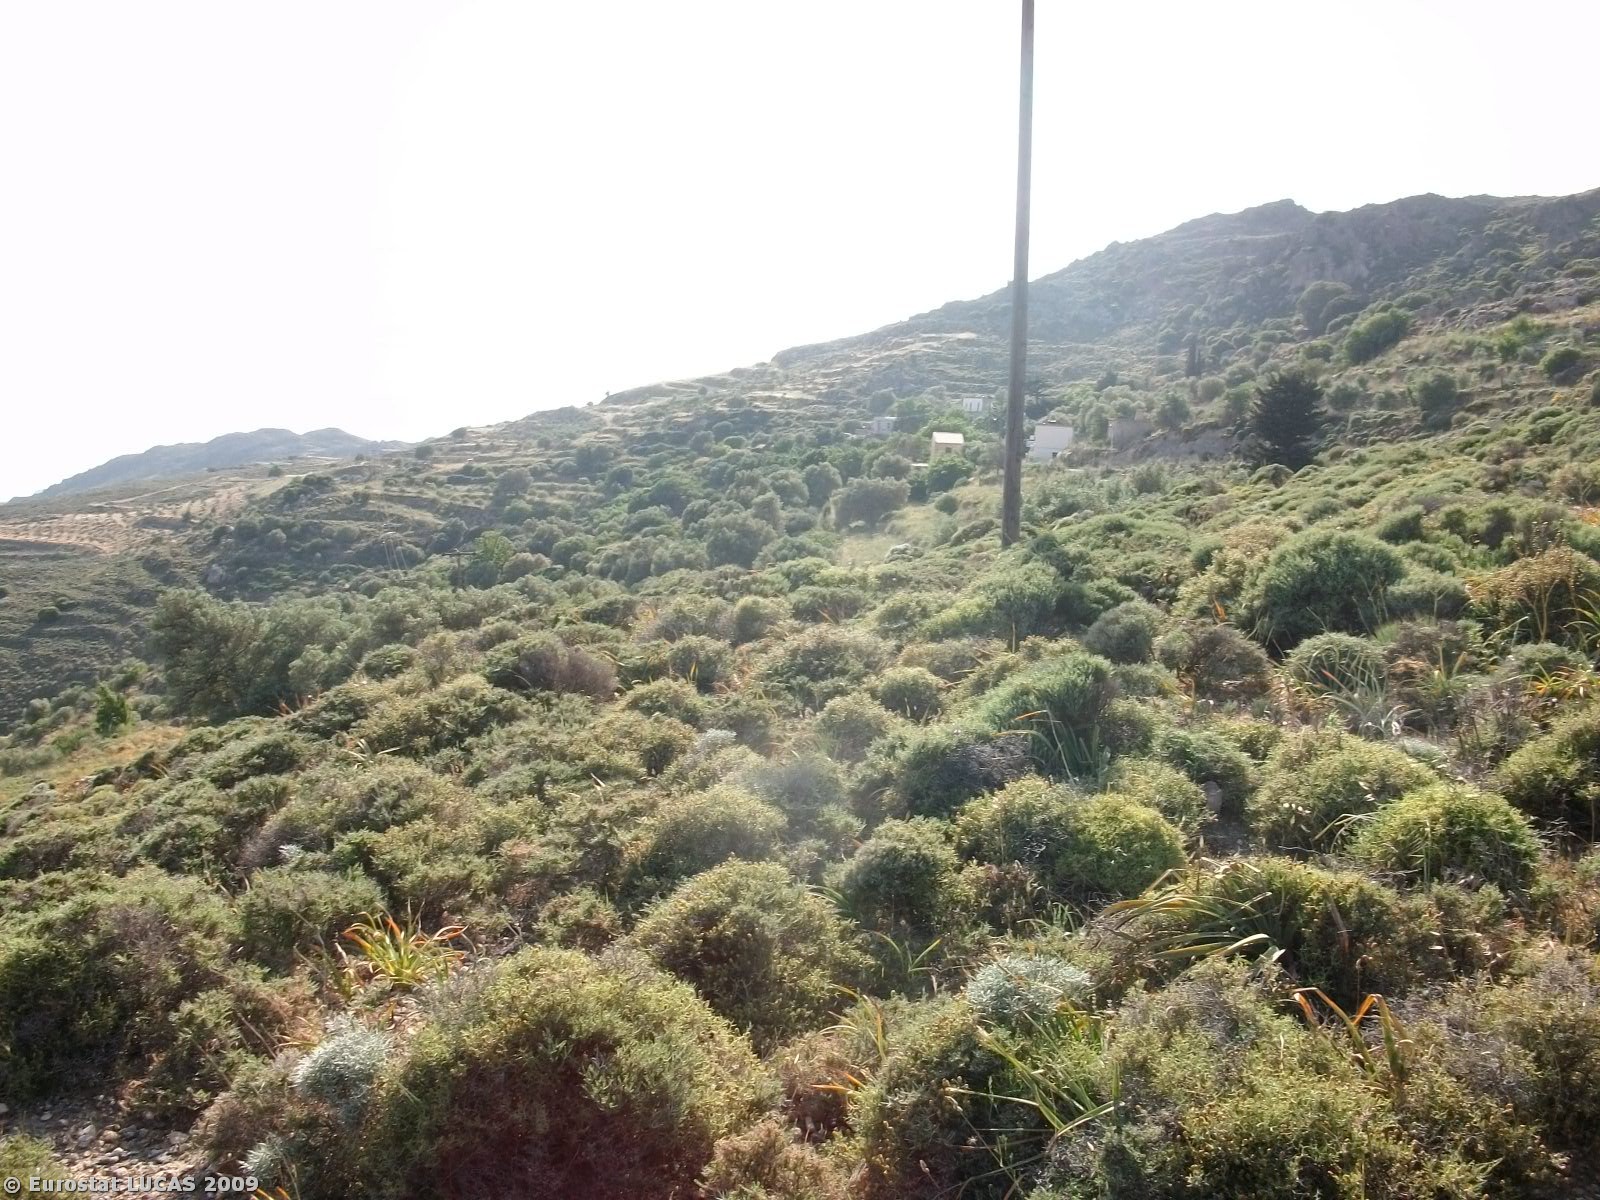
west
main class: Shrubland
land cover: Shrubland without tree cover
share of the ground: > 75 %
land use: Agriculture (excluding fallow land and kitchen gardens)
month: June
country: GR
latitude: 35.2721
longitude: 23.7541
